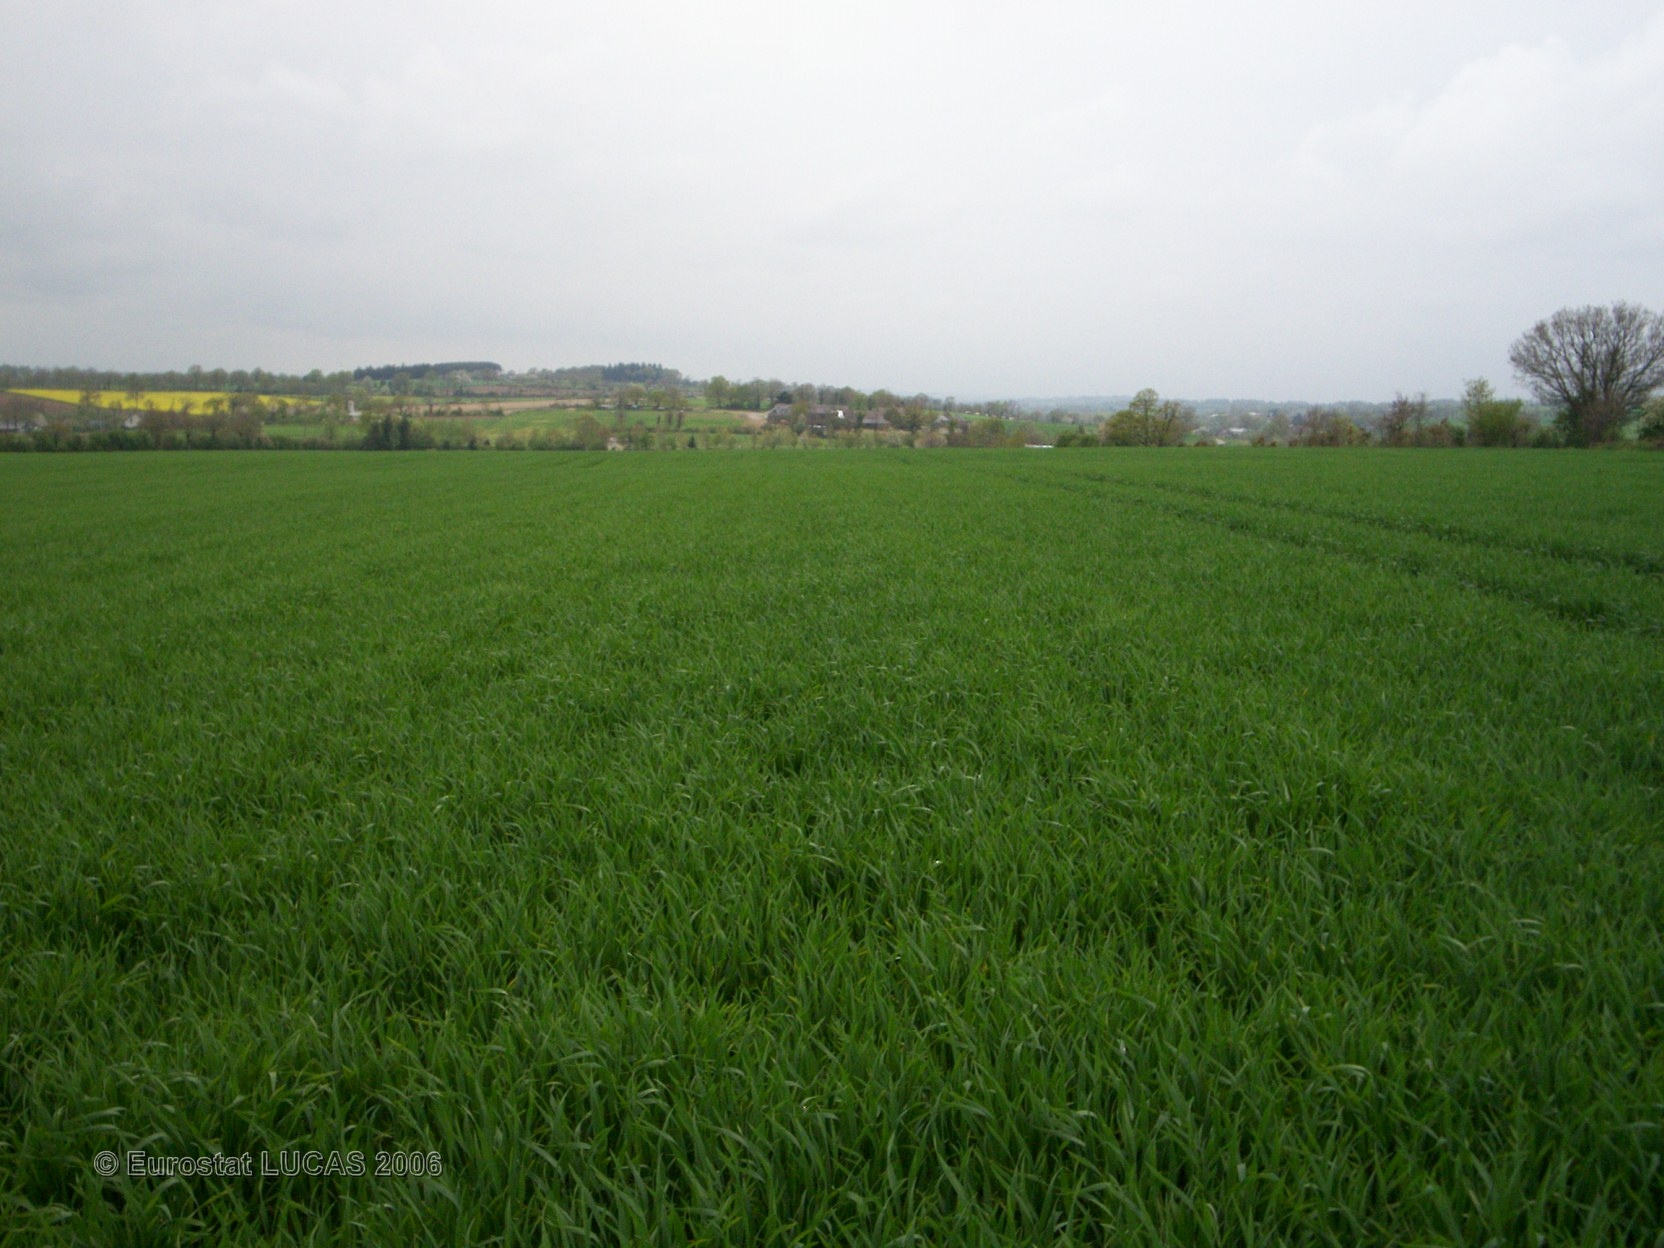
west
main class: Cropland
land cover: Common wheat
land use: Agriculture (excluding fallow land and kitchen gardens)
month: April
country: FR
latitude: 47.8680
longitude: -1.5557
